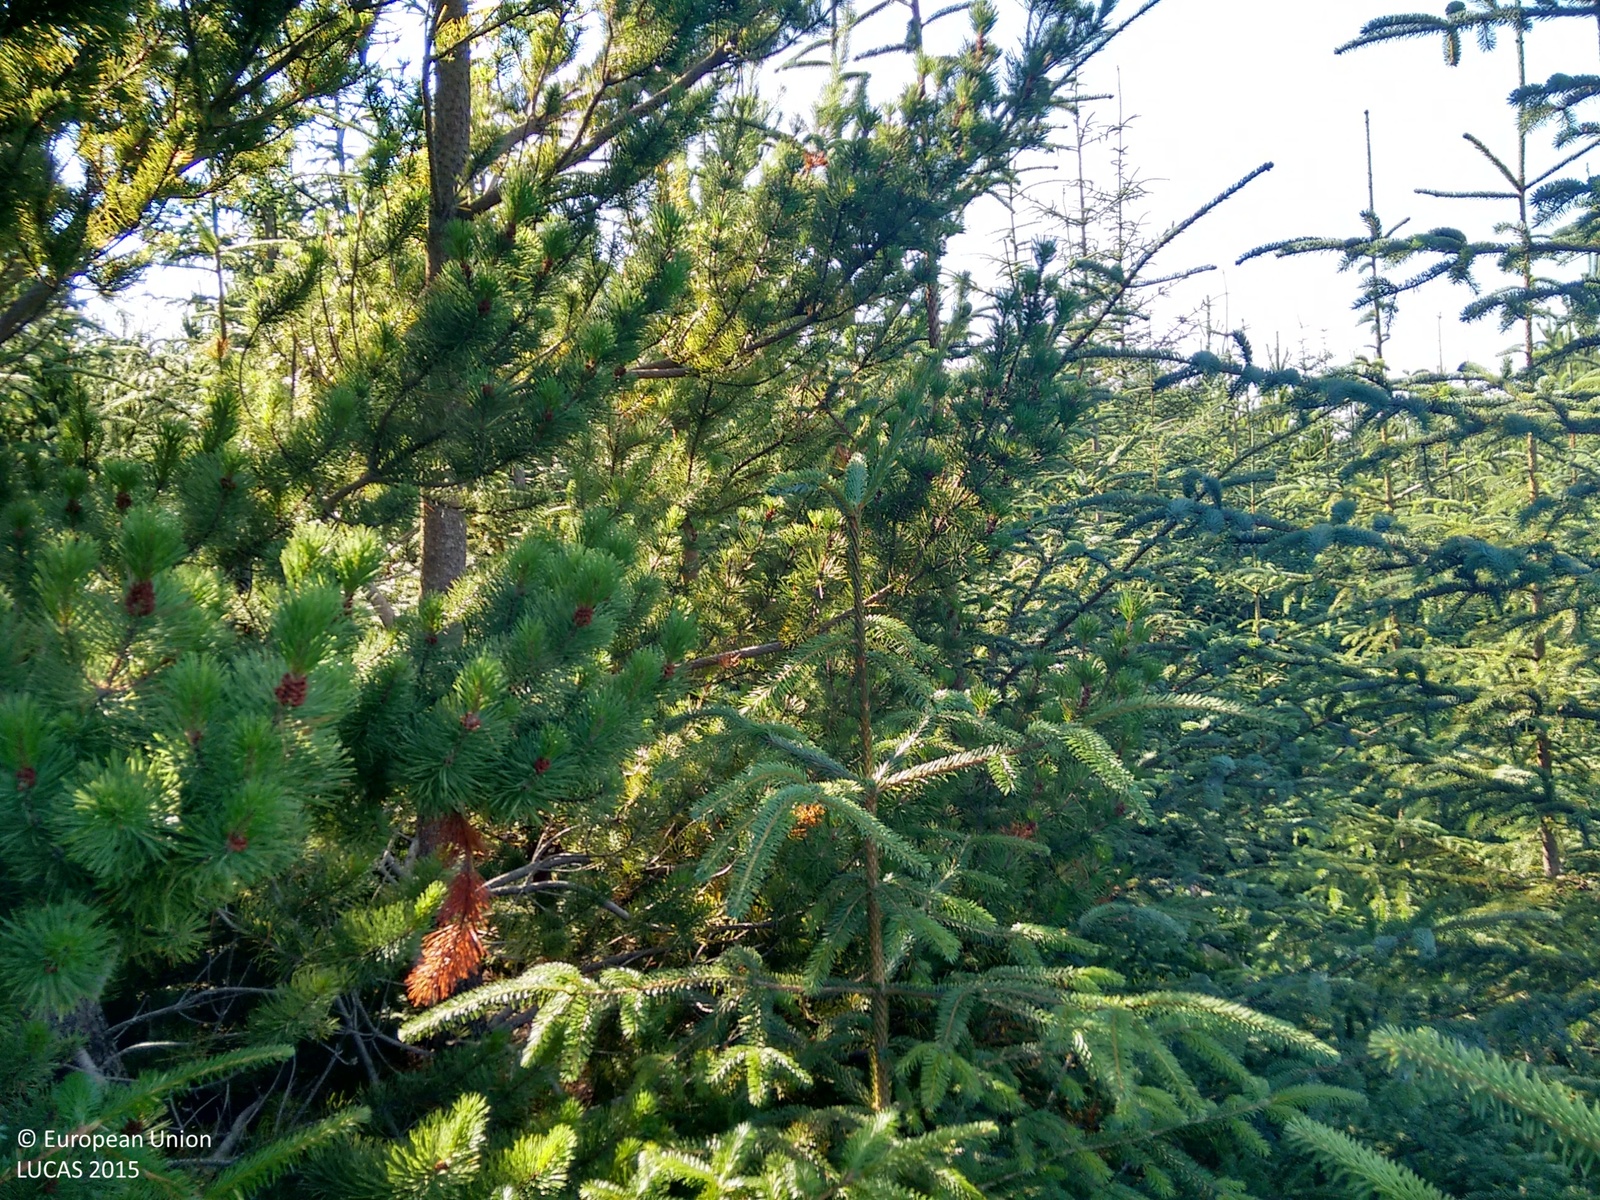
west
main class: Woodland
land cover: Spruce dominated coniferous woodland
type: exotic forest
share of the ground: > 75 %
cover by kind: coniferous forest trees 95 %, shrubs 5 %
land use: Forestry
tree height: > 5 m
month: September
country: GB
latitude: 58.4790
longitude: -4.2622
